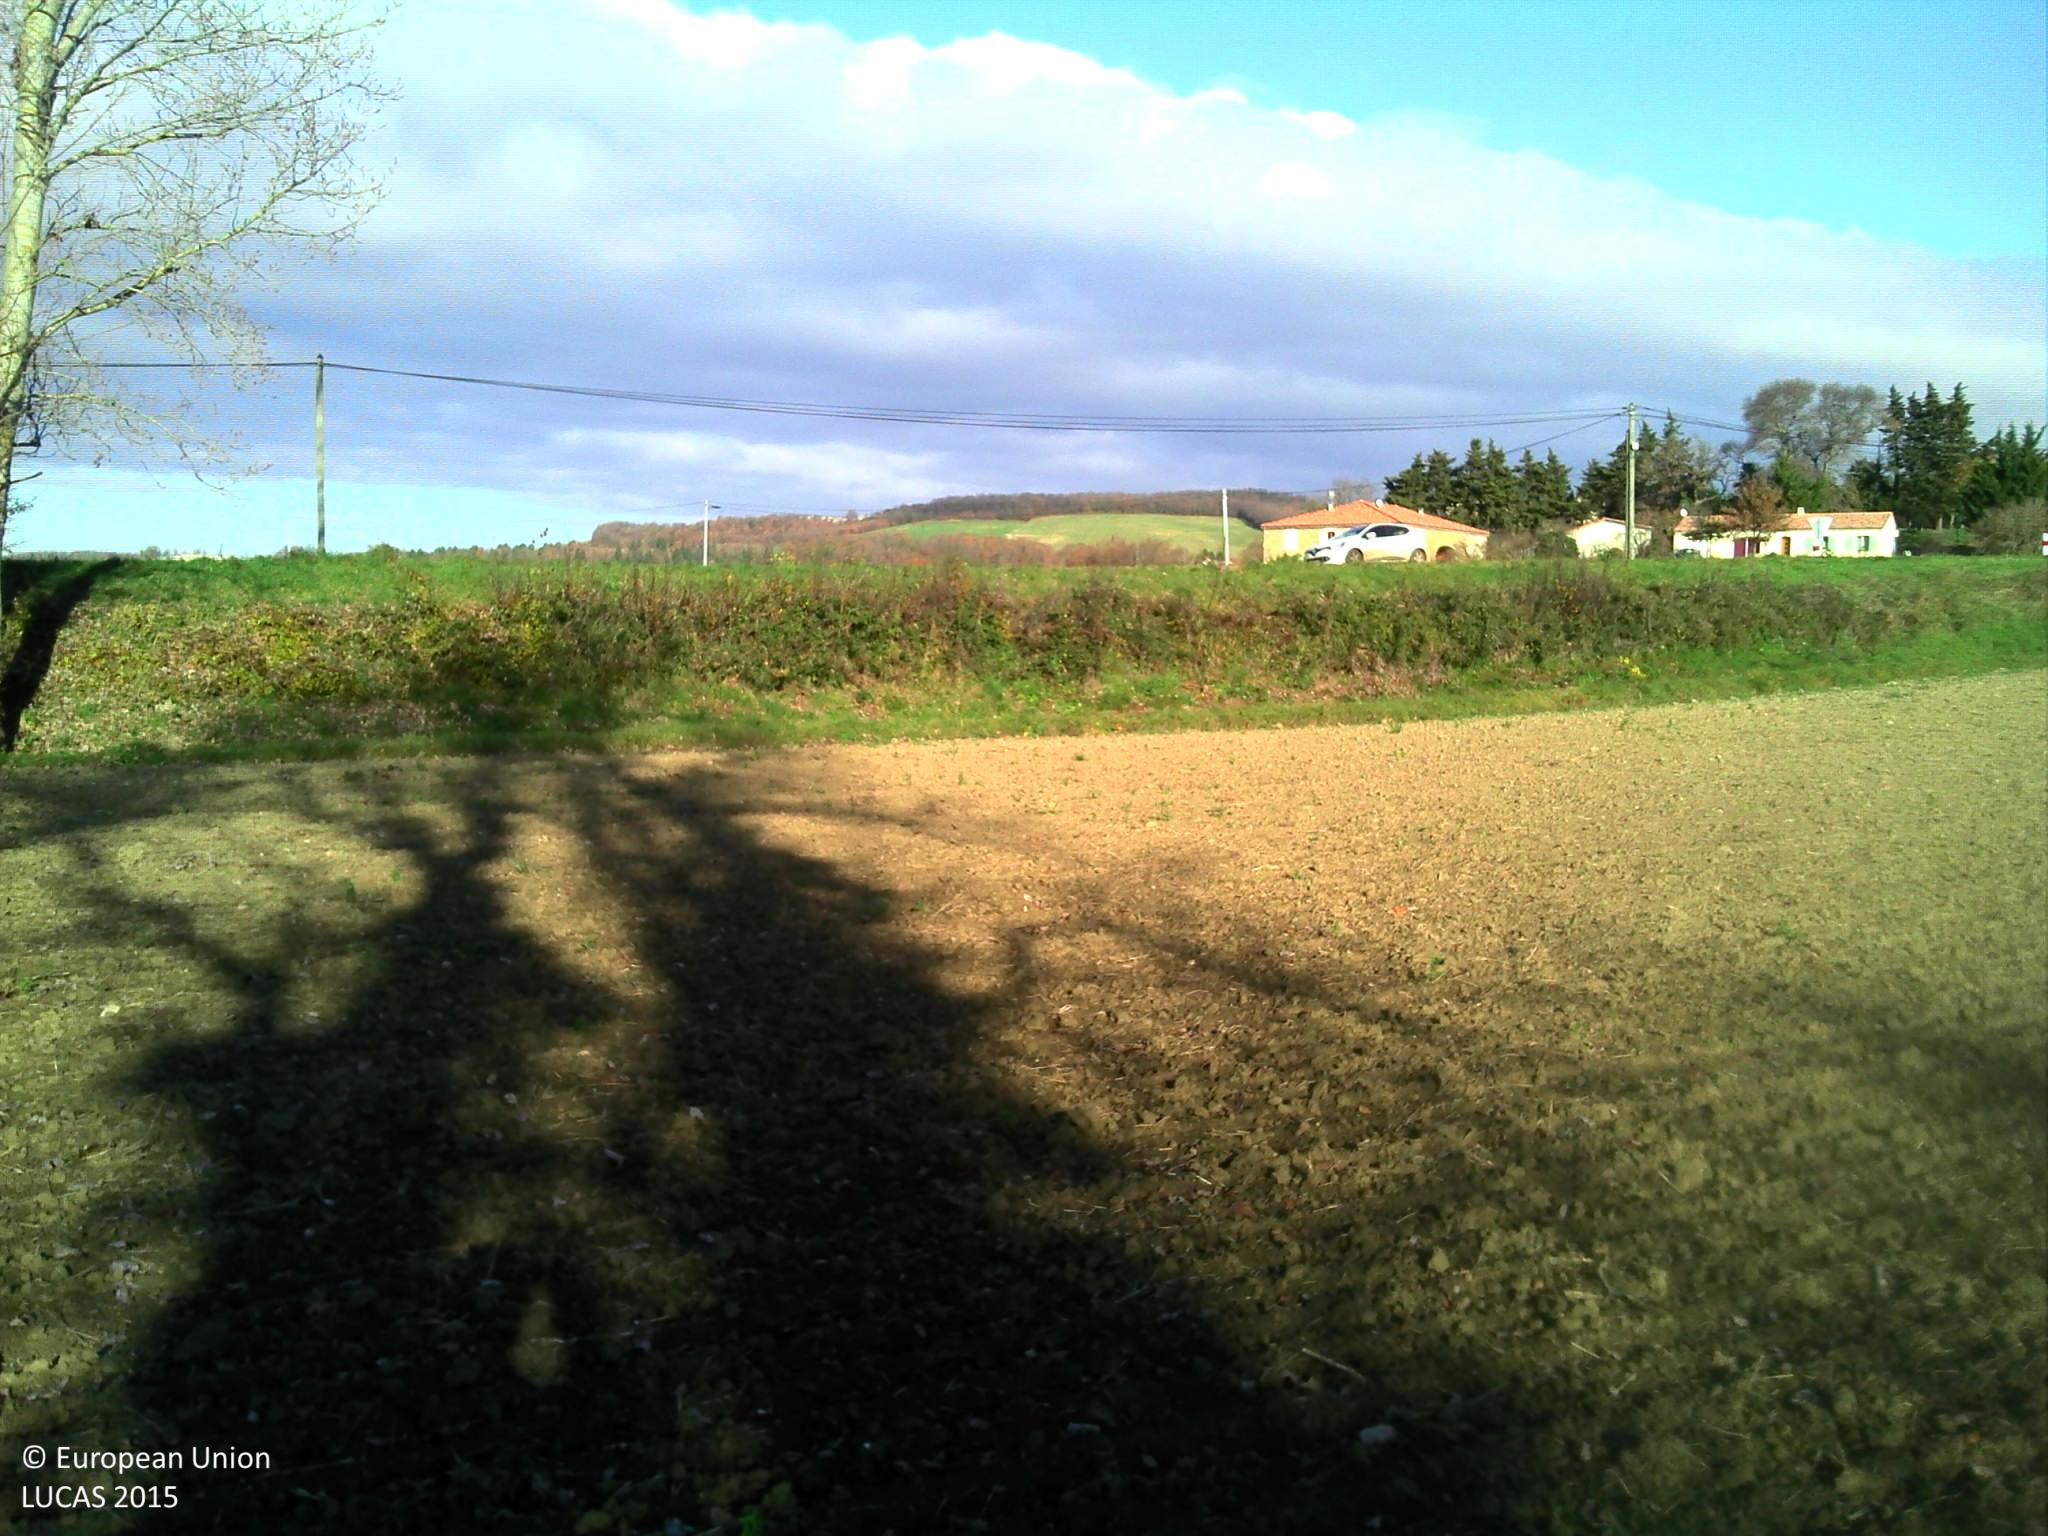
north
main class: Cropland
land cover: Common wheat
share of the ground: > 75 %
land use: Agriculture (excluding fallow land and kitchen gardens)
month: December
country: FR
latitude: 44.6636
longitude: 4.9994
